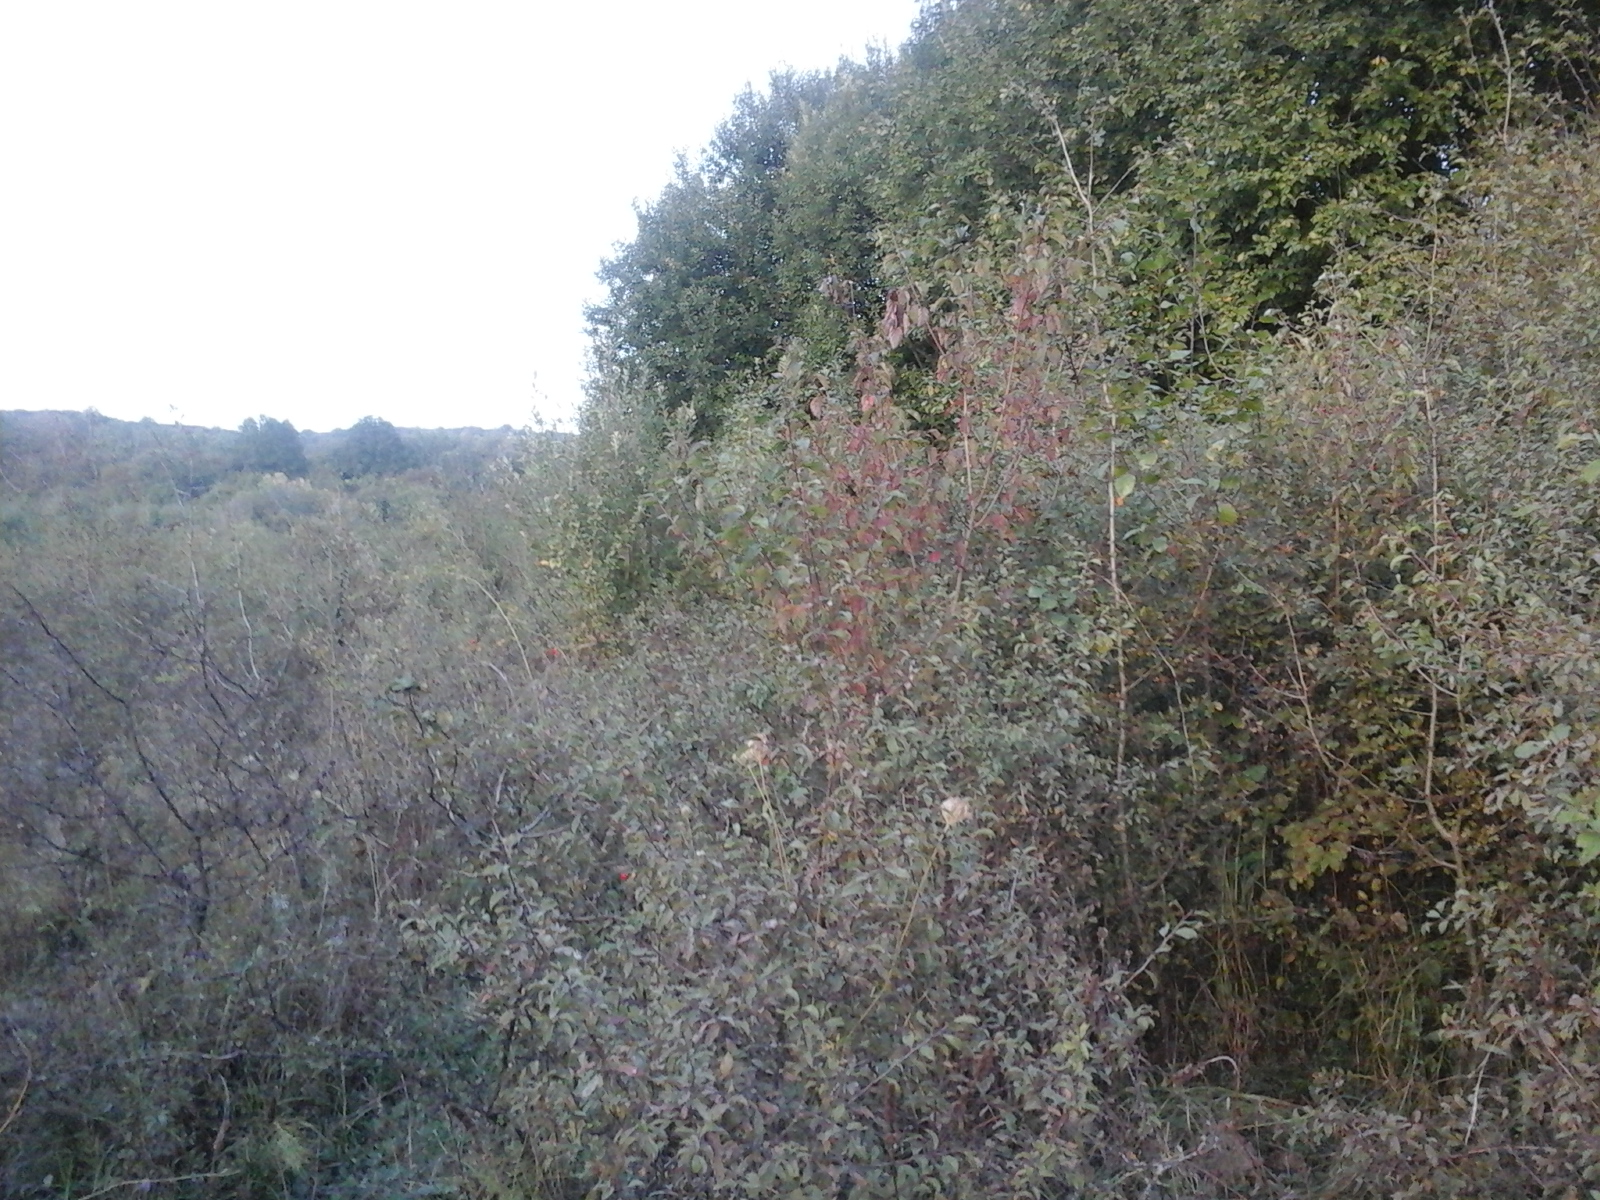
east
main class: Shrubland
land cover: Shrubland without tree cover
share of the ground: > 75 %
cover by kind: shrubs 100 %
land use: Semi-natural and natural areas not in use
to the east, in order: Shrubland without tree cover; Broadleaved woodland; Shrubland without tree cover; Grassland without tree/shrub cover
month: September
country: RO
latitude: 46.9639
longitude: 24.1048
